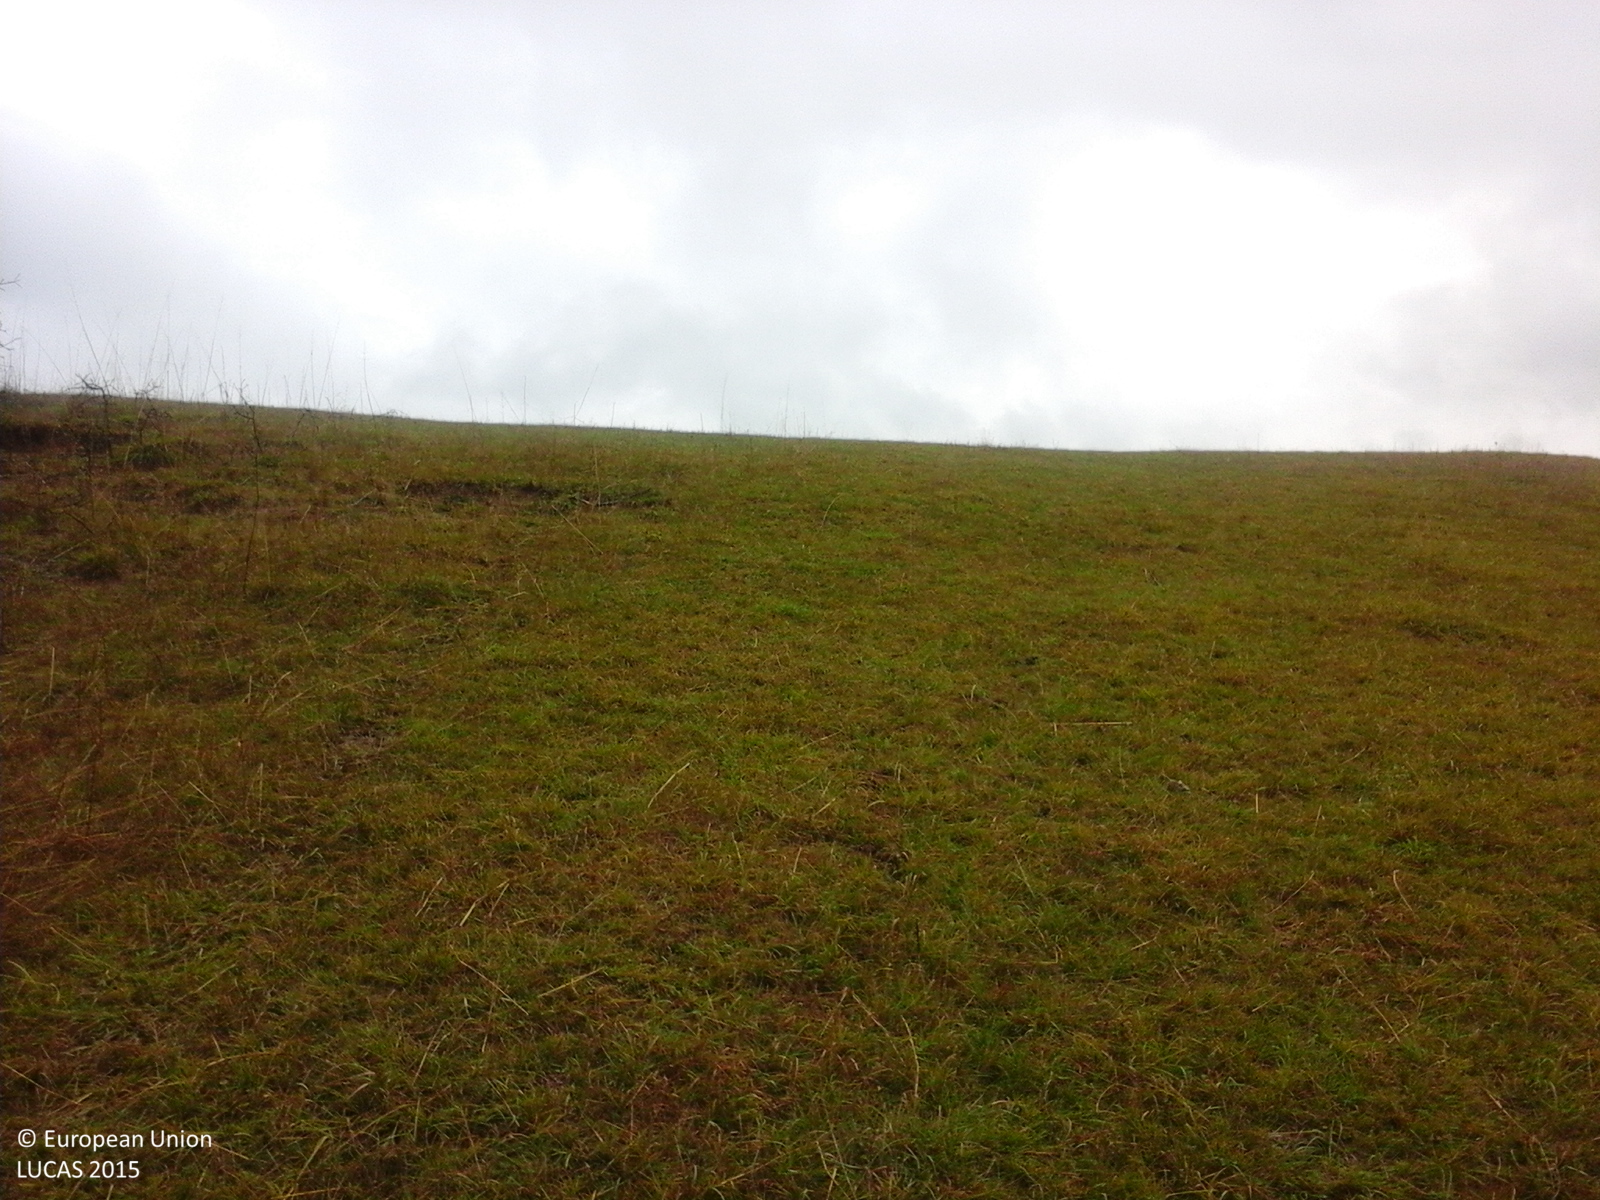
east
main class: Grassland
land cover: Grassland without tree/shrub cover
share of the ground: > 75 %
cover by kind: herbaceous plants 100 %
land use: Agriculture (excluding fallow land and kitchen gardens)
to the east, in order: Grassland without tree/shrub cover; Tracks; Grassland with sparse tree/shrub cover; Tracks; Grass margins; Broadleaved woodland
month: September
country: RO
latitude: 45.1516
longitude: 23.5806
